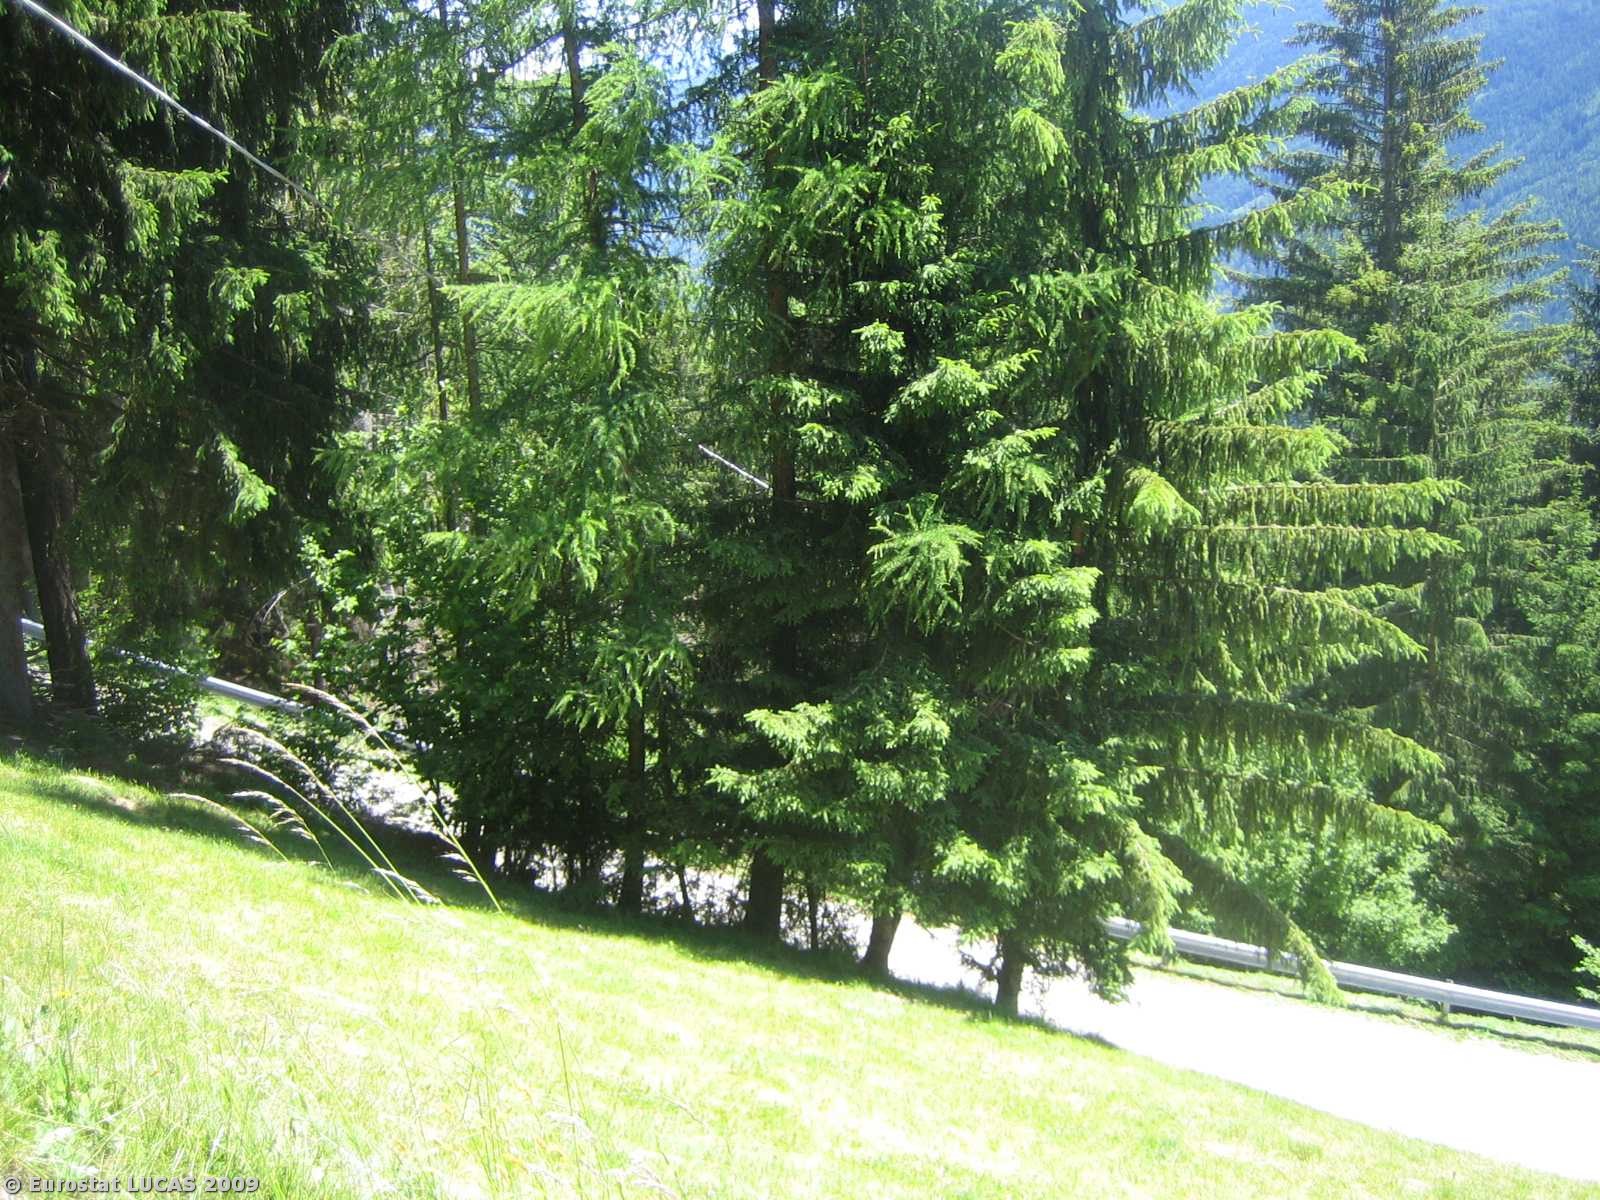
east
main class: Artificial land
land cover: Non built-up linear features
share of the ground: > 75 %
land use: Road transport
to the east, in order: Non built-up linear features; Coniferous woodland; Paved roads, cycling and walking lanes; Grassland without tree/shrub cover; Electric lines; Coniferous woodland; Paved roads, cycling and walking lanes; Coniferous woodland; Artificial constructions; Paved roads, cycling and walking lanes; Coniferous woodland
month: June
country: IT
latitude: 46.8242
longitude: 11.6892
